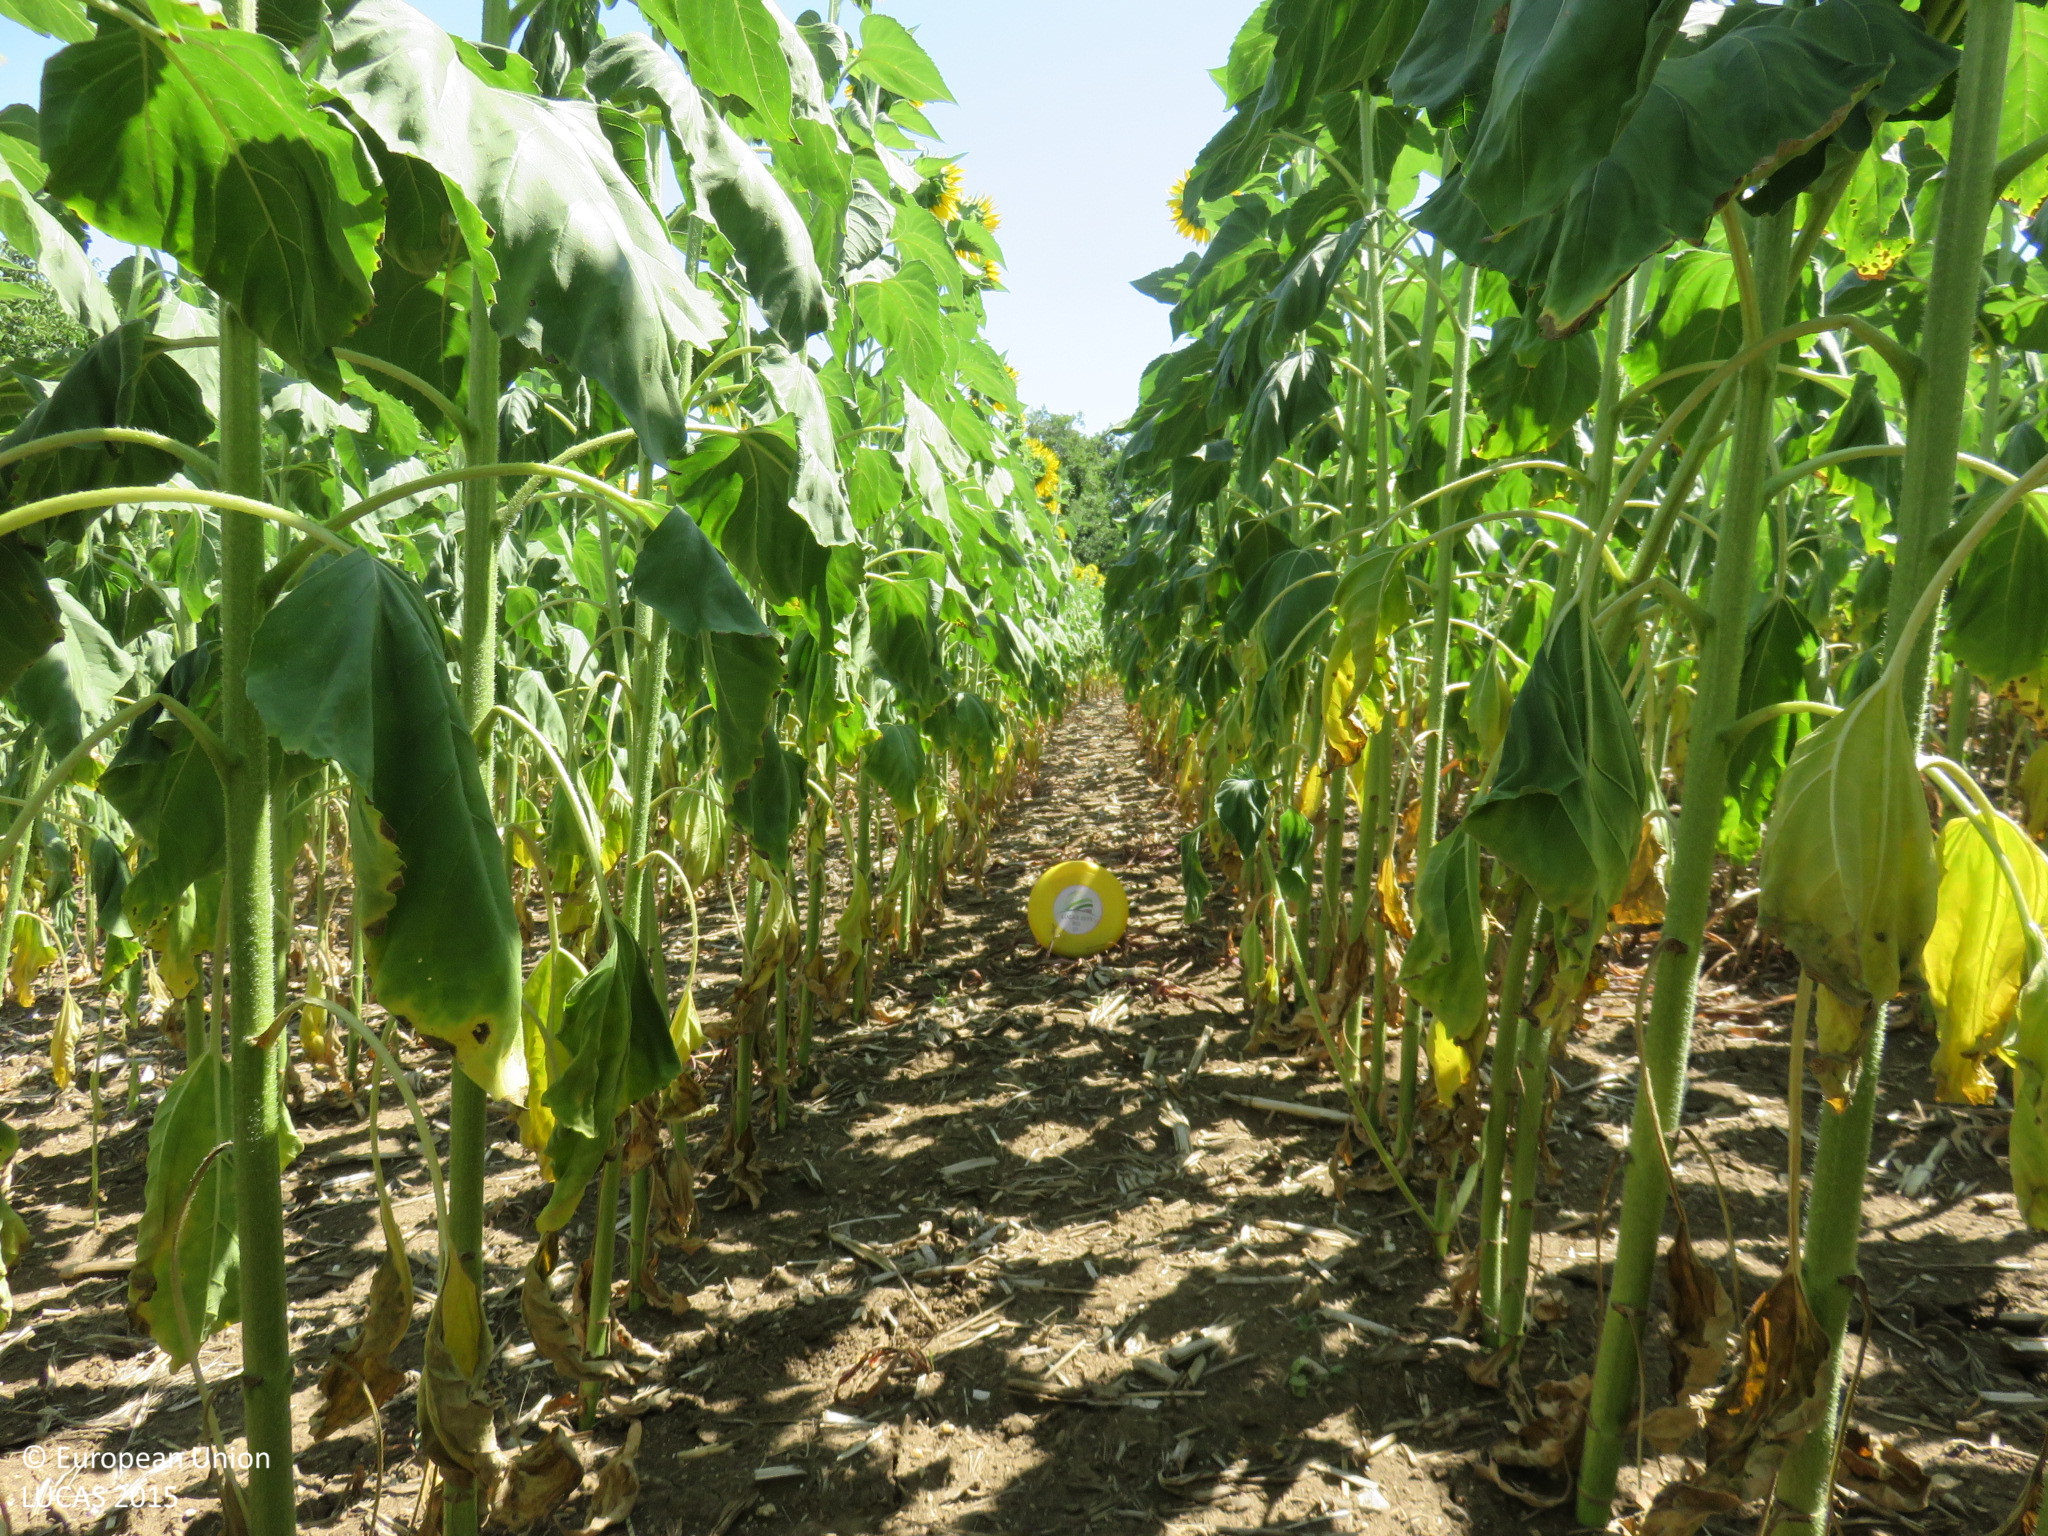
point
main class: Cropland
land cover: Sunflower
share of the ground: > 75 %
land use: Agriculture (excluding fallow land and kitchen gardens)
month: July
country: BG
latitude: 43.2407
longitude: 25.0820
